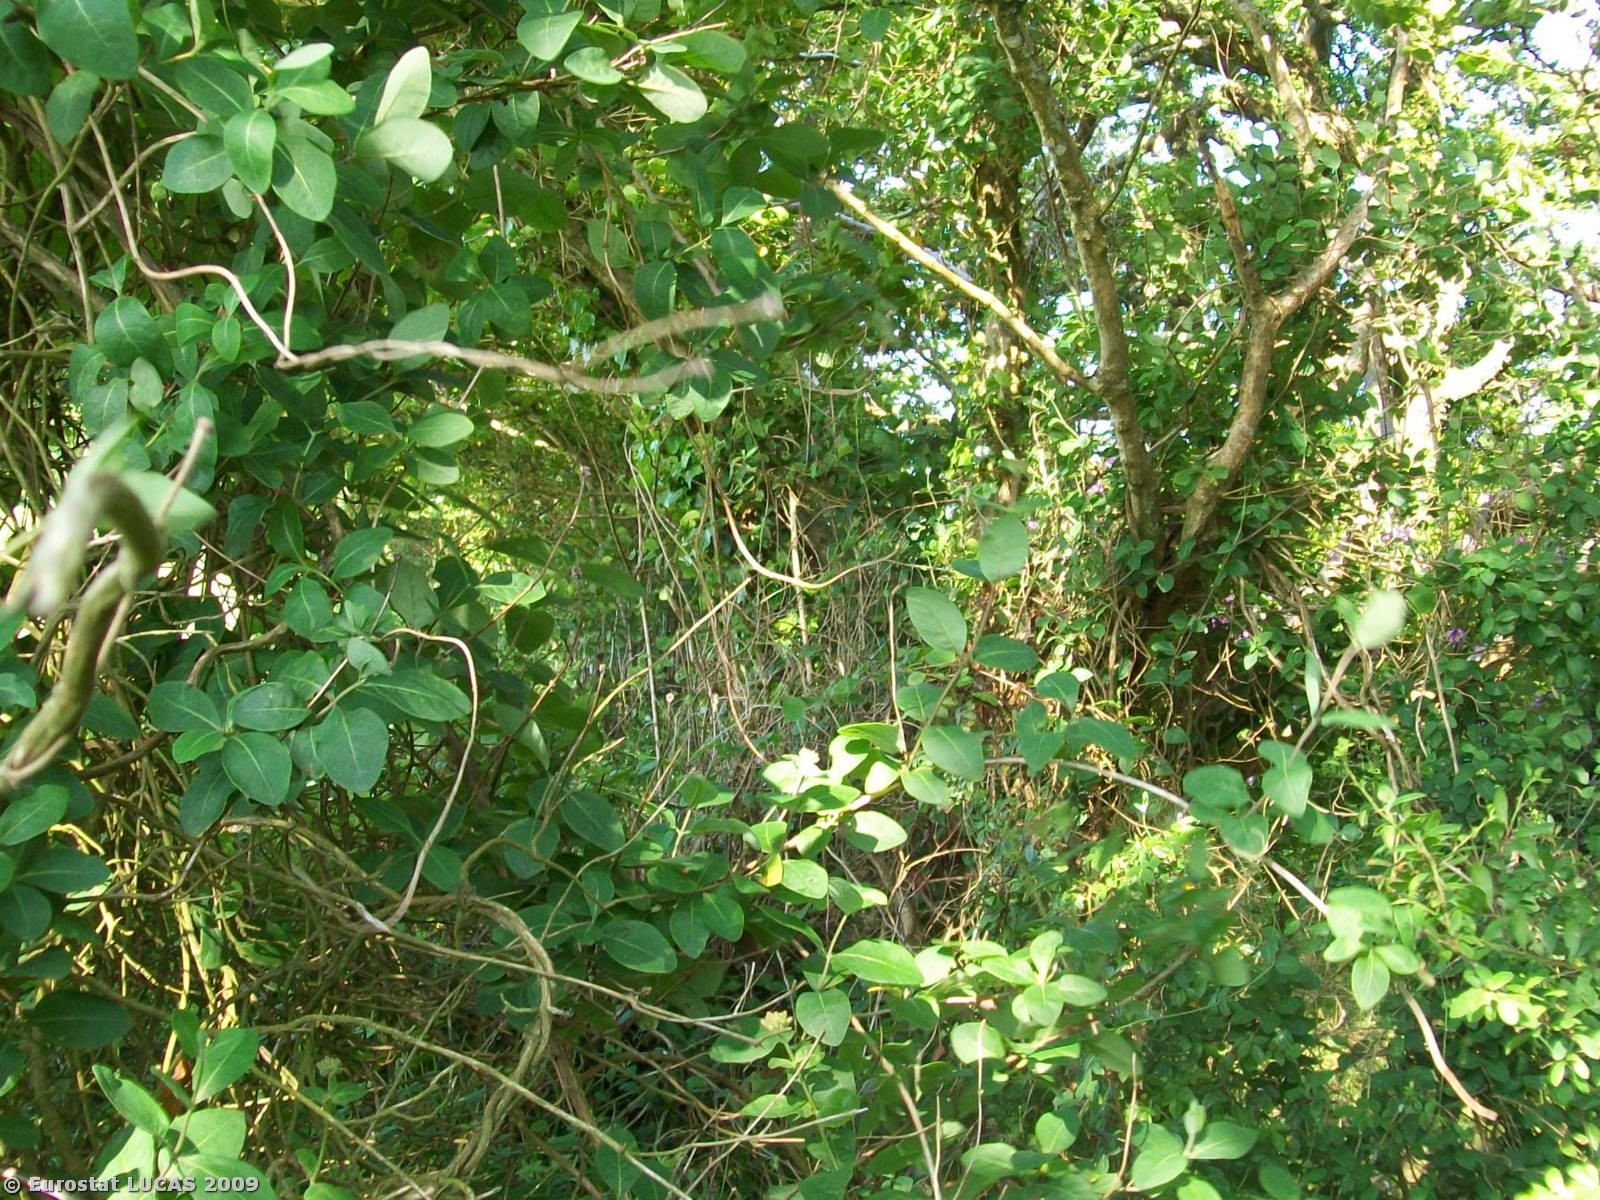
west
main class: Grassland
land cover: Grassland without tree/shrub cover
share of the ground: > 75 %
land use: Agriculture (excluding fallow land and kitchen gardens)
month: June
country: GB
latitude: 50.1791
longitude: -5.0870
